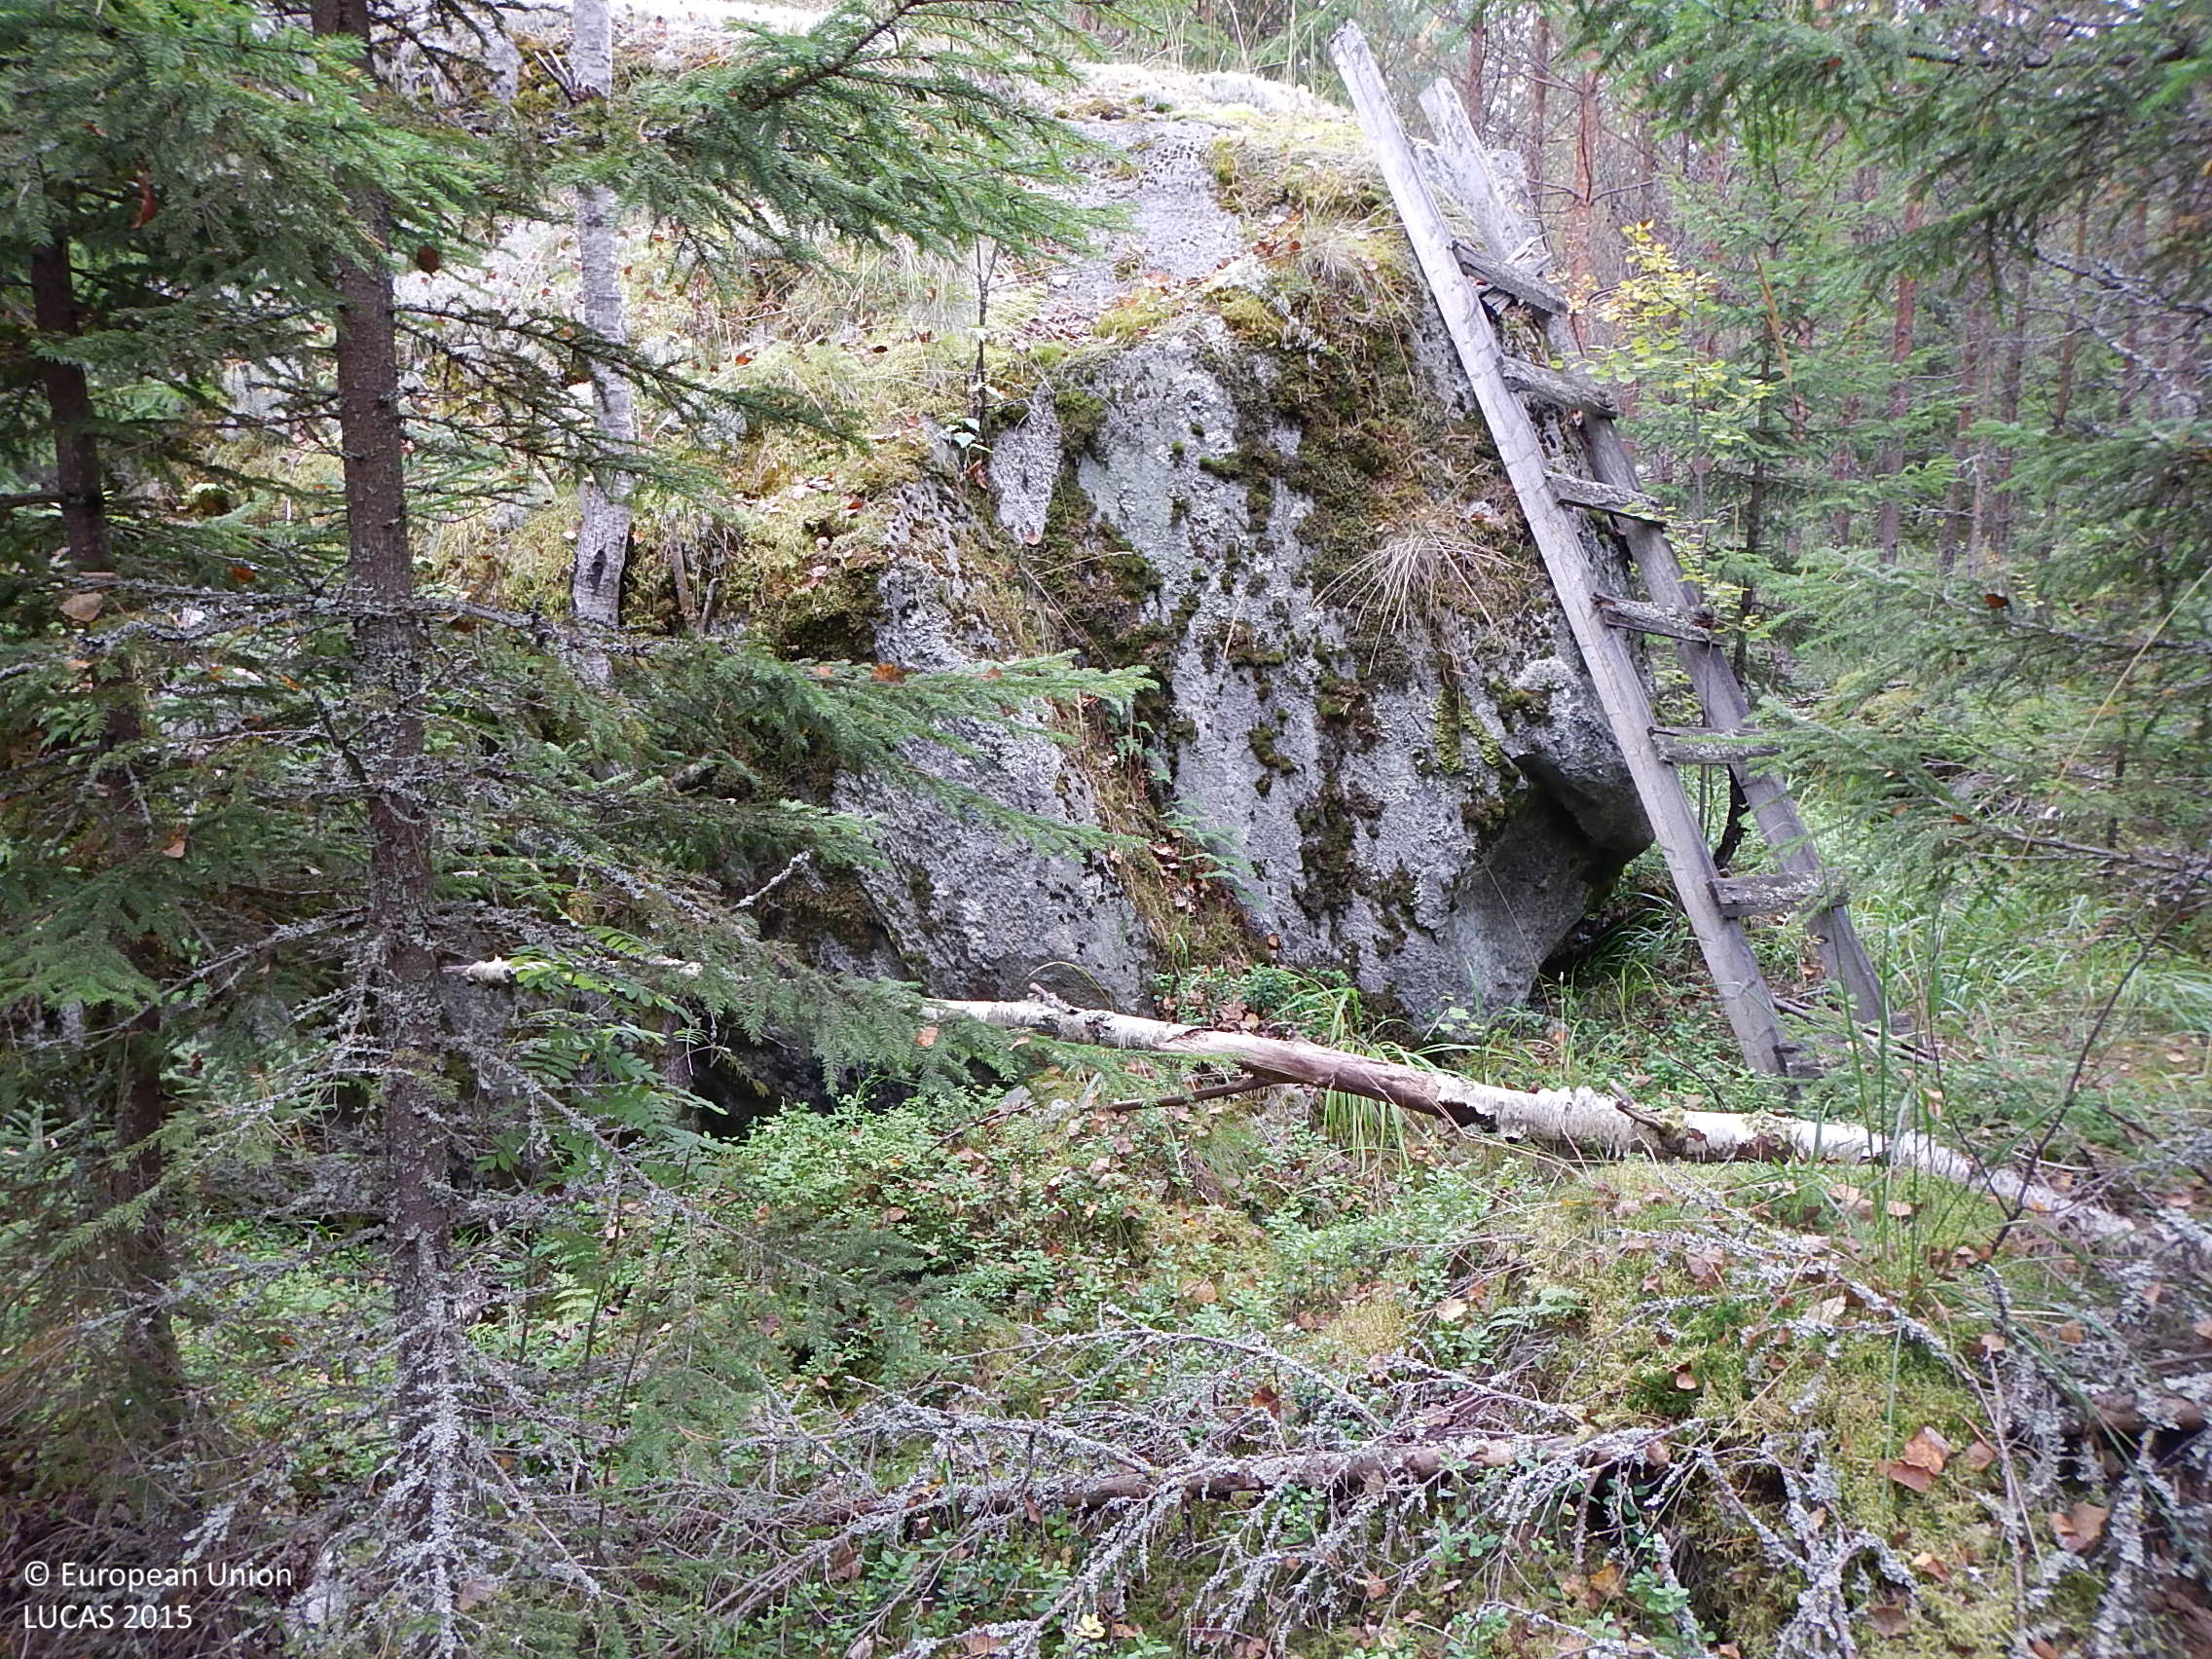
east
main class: Woodland
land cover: Other coniferous woodland
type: boreal forest
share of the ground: > 75 %
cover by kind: coniferous forest trees 60 %, broadleaved forest trees 15 %, shrubs 15 %, herbaceous plants 5 %, lichens and mosses 5 %
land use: Forestry
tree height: > 5 m
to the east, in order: Other coniferous woodland; Pine dominated coniferous woodland; Shrubland without tree cover; Electric lines; Shrubland without tree cover; Spruce dominated mixed woodland; Other mixed woodland; Spruce dominated mixed woodland
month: September
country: FI
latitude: 61.5426
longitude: 22.0404
